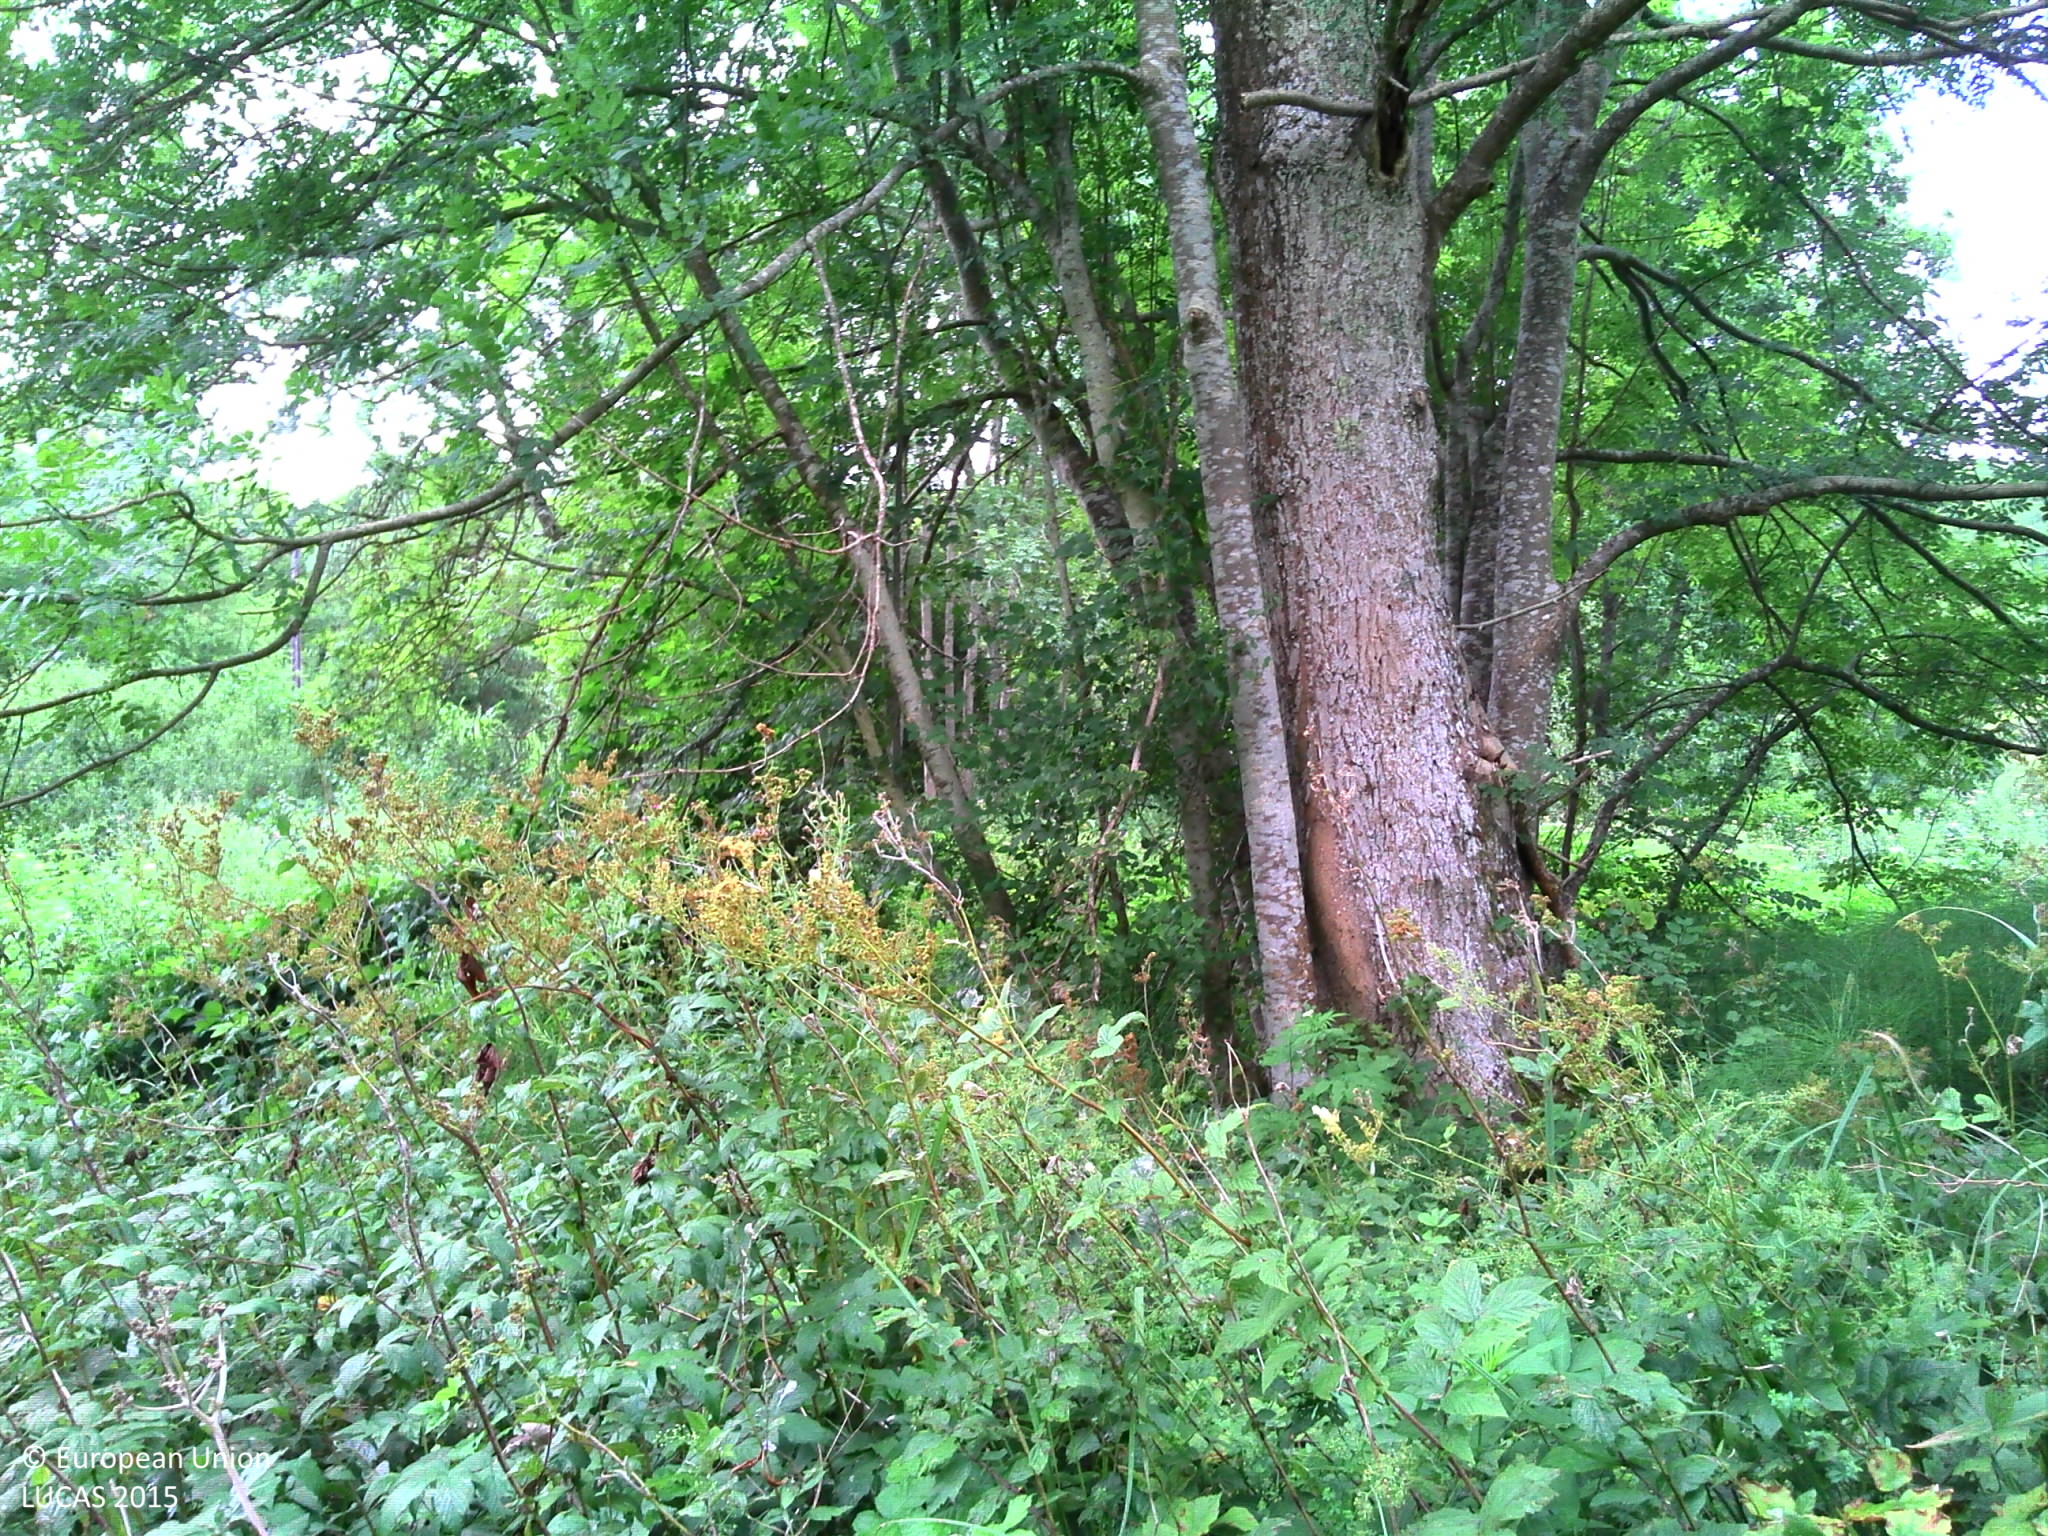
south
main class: Grassland
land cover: Spontaneously vegetated surfaces
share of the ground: > 75 %
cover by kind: herbaceous plants 95 %, shrubs 5 %
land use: Semi-natural and natural areas not in use
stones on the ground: < 10 %
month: July
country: FR
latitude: 44.9369
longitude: 0.7793
